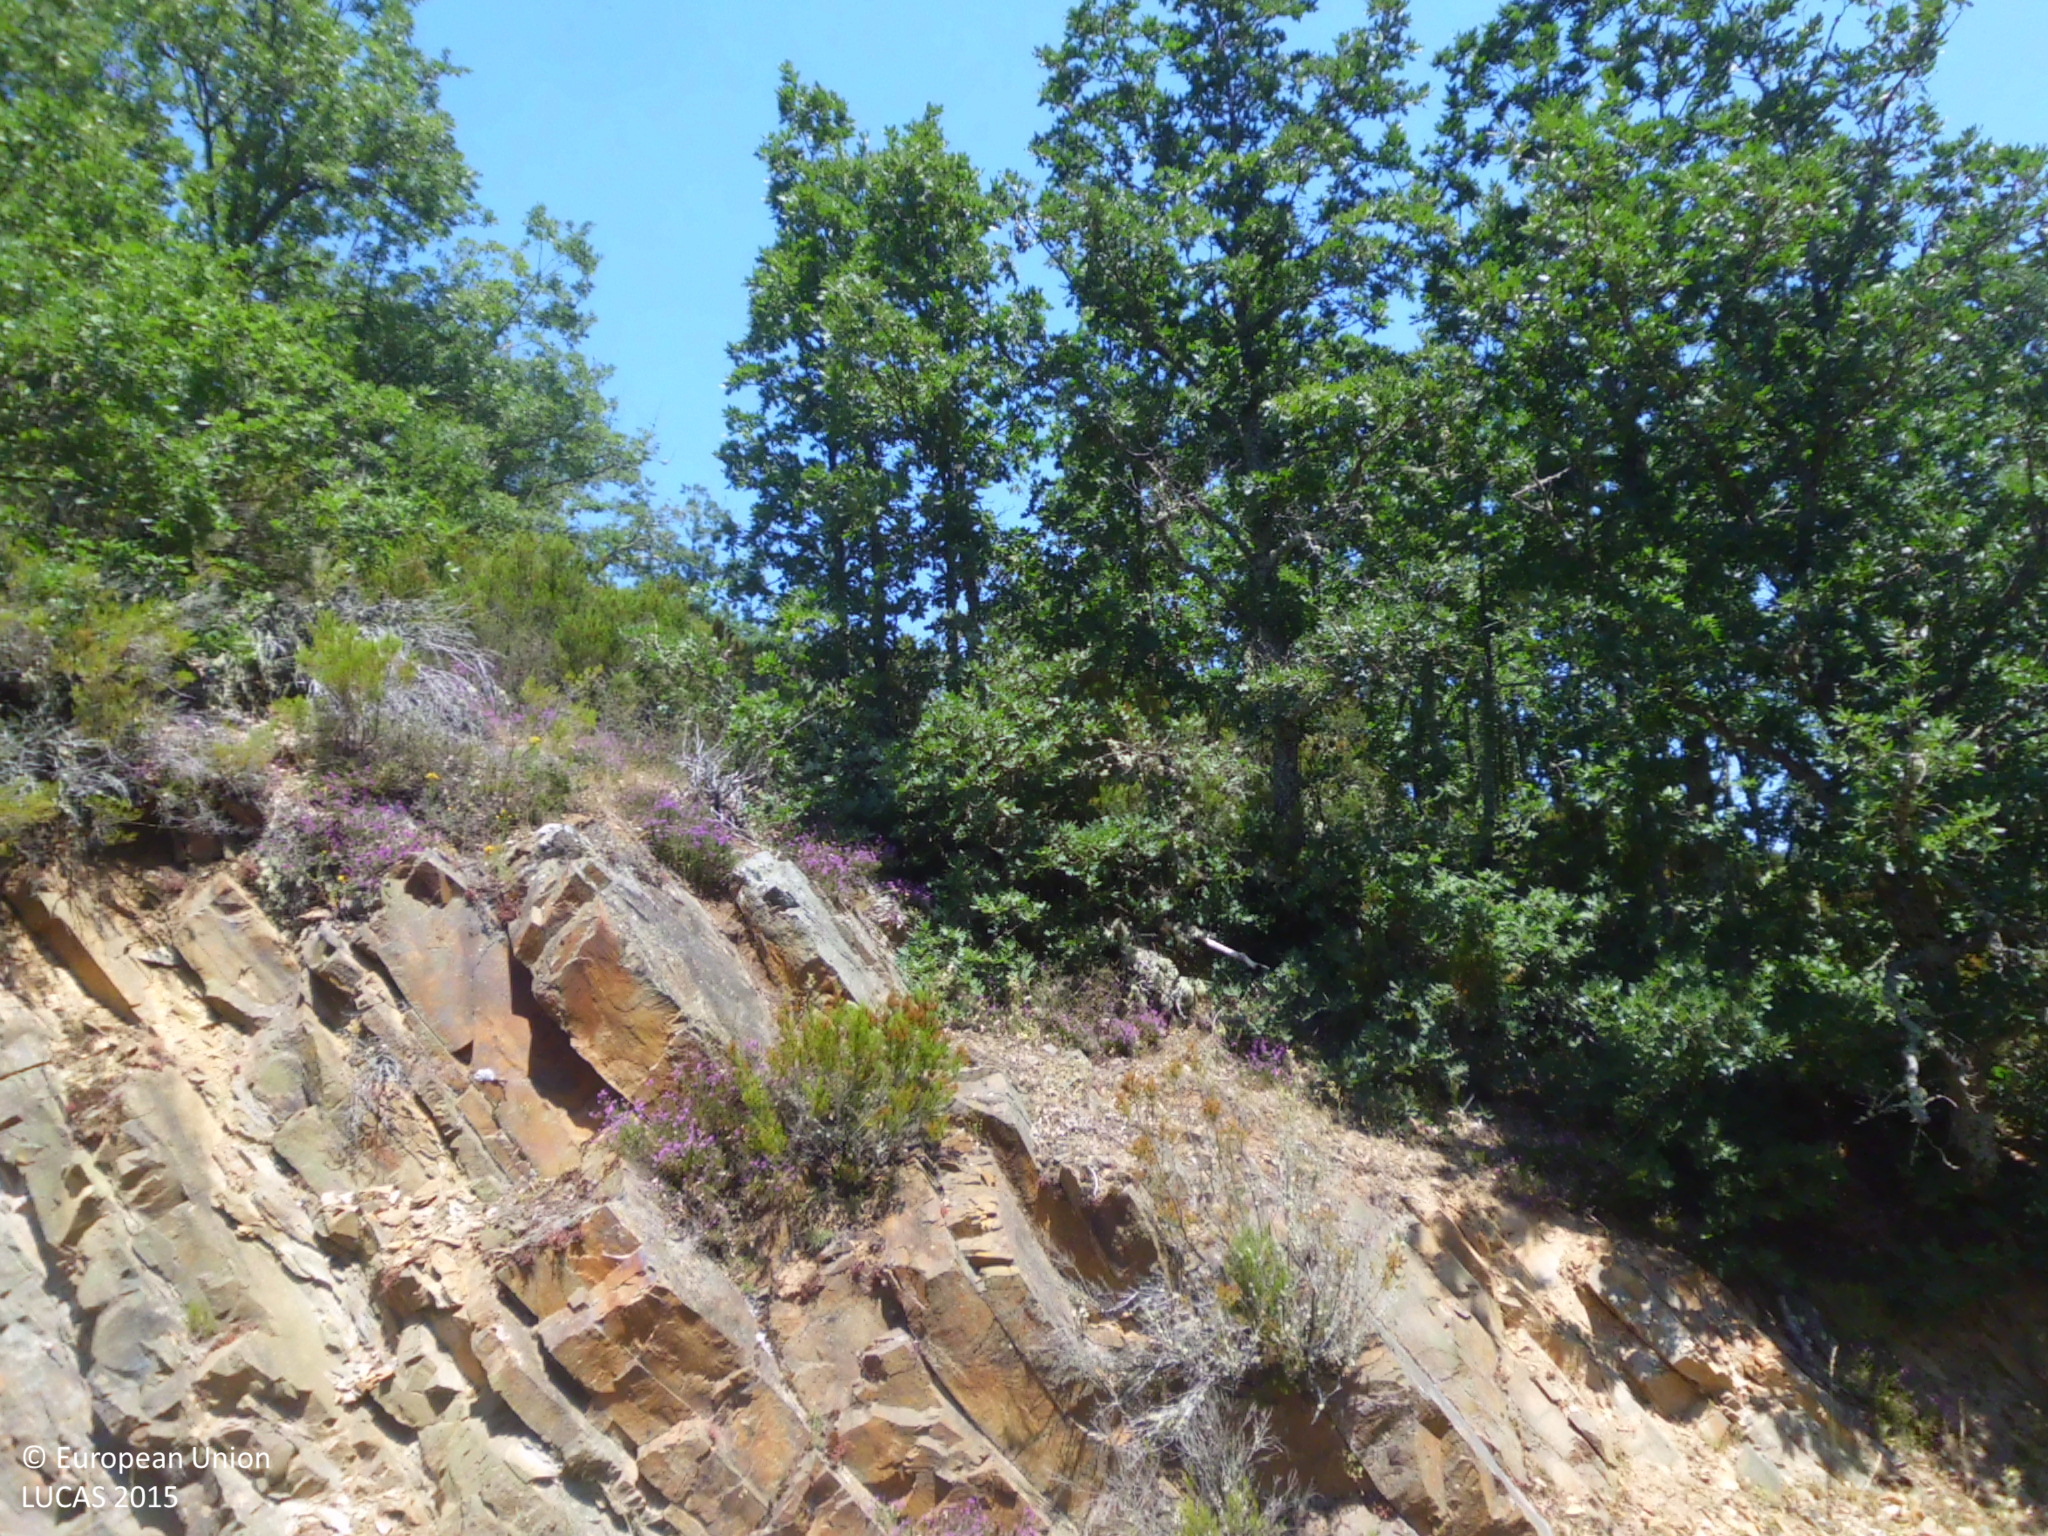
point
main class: Woodland
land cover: Broadleaved woodland
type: acidophilous oak and oak-birch forest
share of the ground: 50 - 75 %
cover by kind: broadleaved forest trees 60 %, shrubs 20 %, herbaceous plants 10 %, consolidated bare surface 10 %
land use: Semi-natural and natural areas not in use
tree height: > 5 m
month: July
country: ES
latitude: 42.2623
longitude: -3.3286
